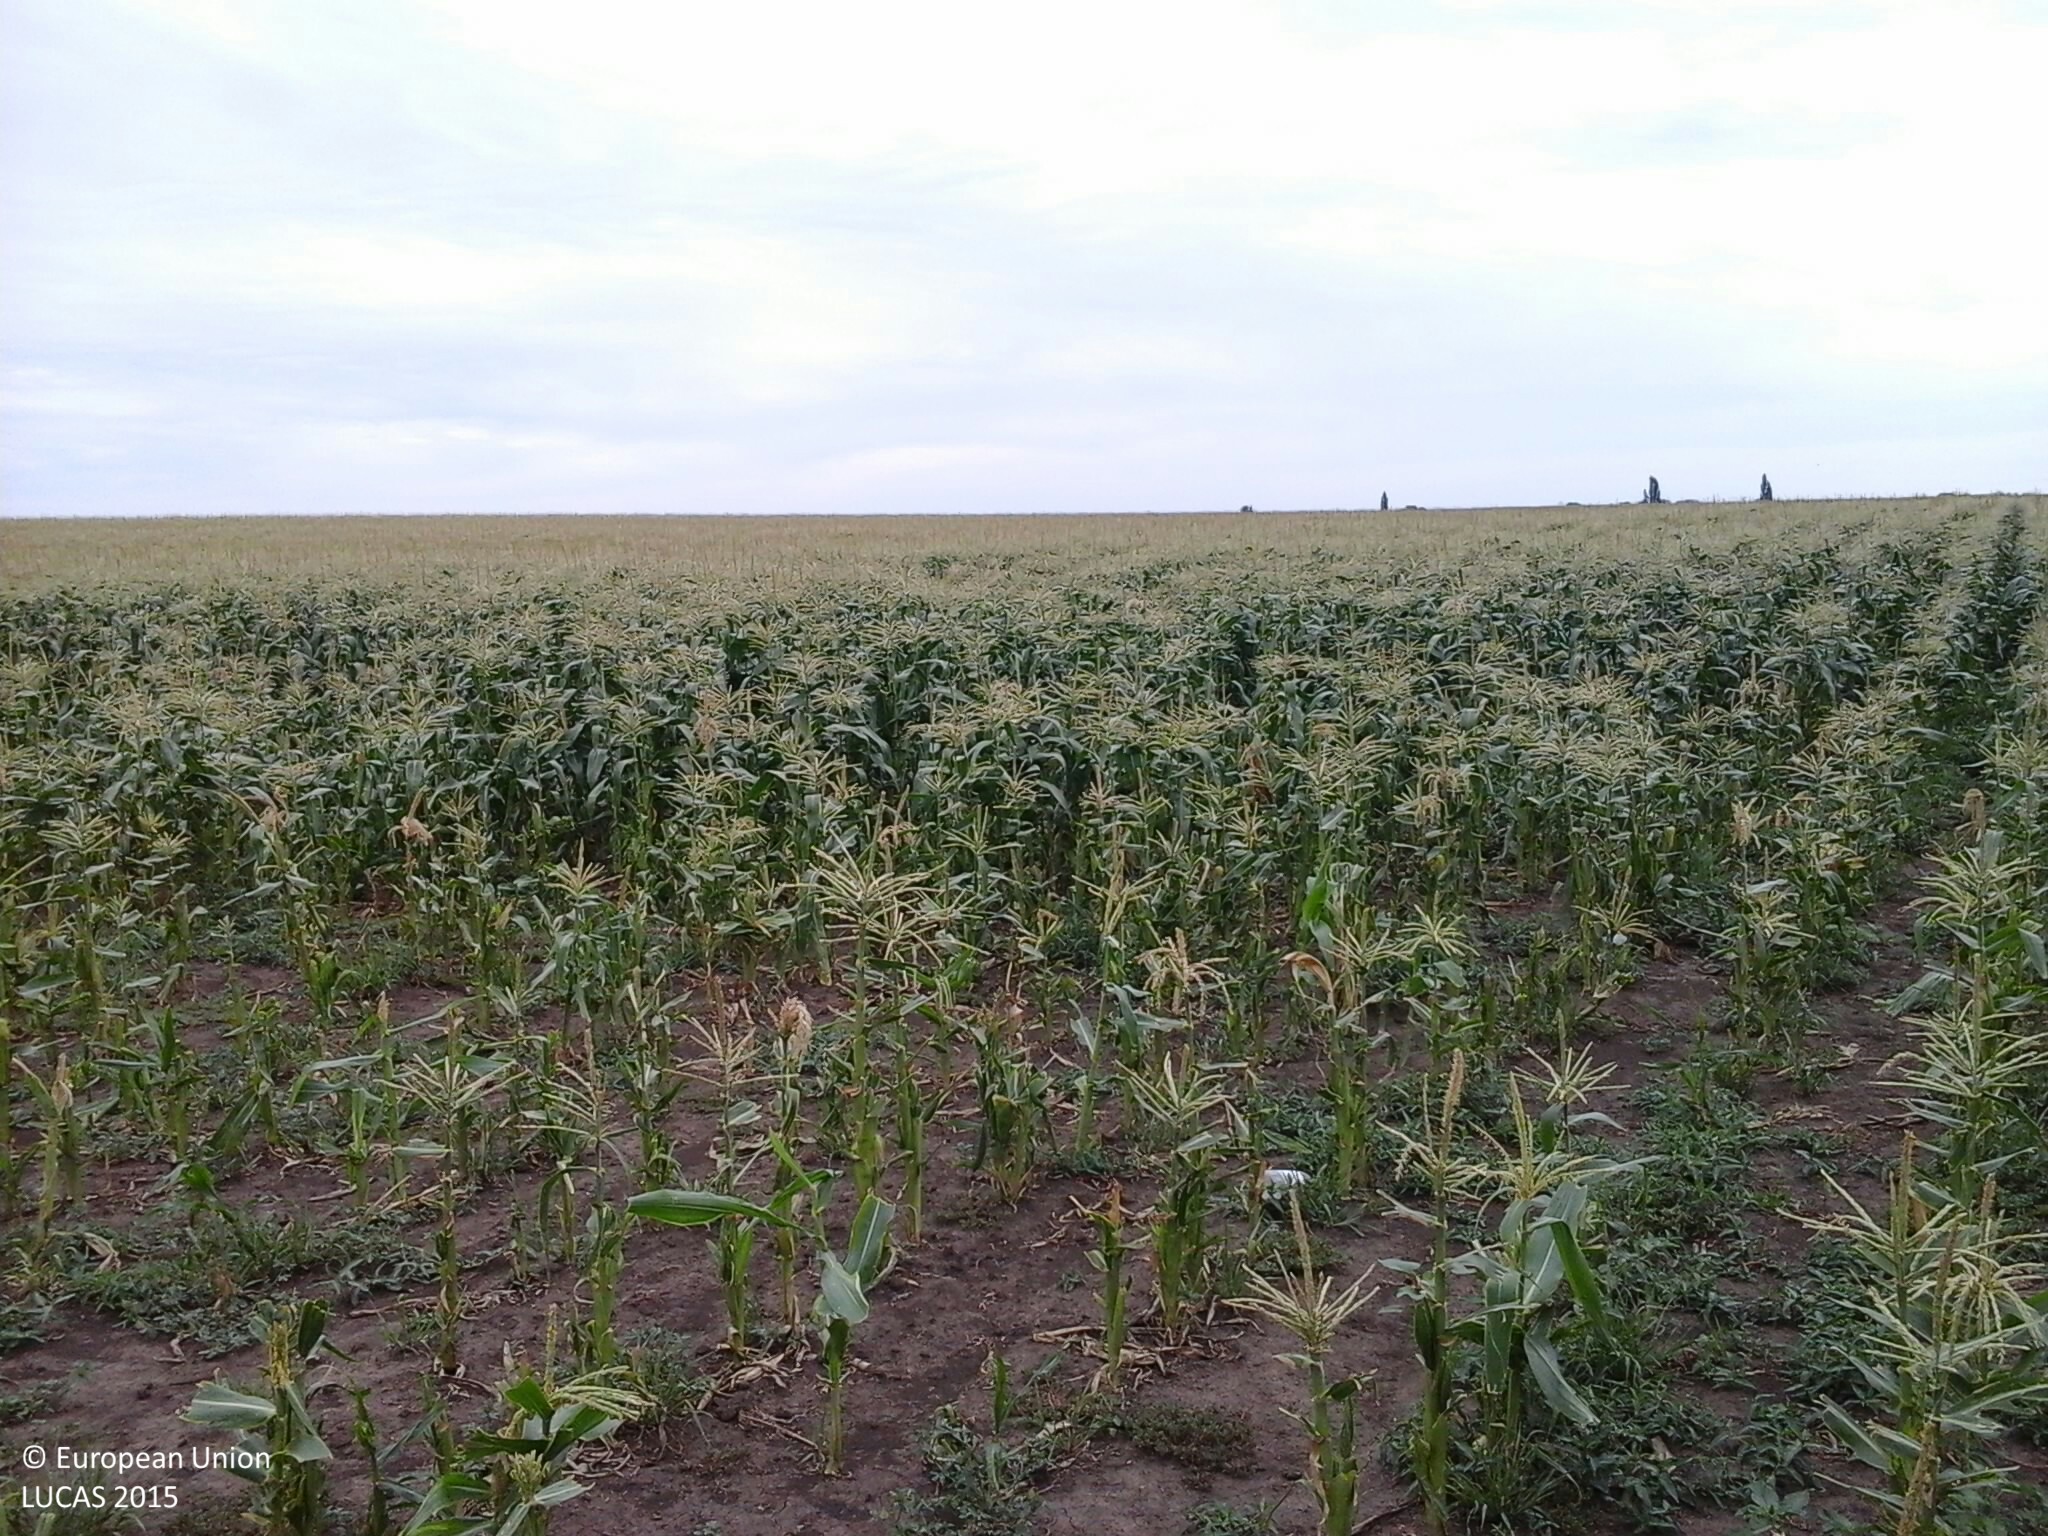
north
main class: Cropland
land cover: Maize
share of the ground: > 75 %
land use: Agriculture (excluding fallow land and kitchen gardens)
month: July
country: HU
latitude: 47.8054
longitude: 21.4602
